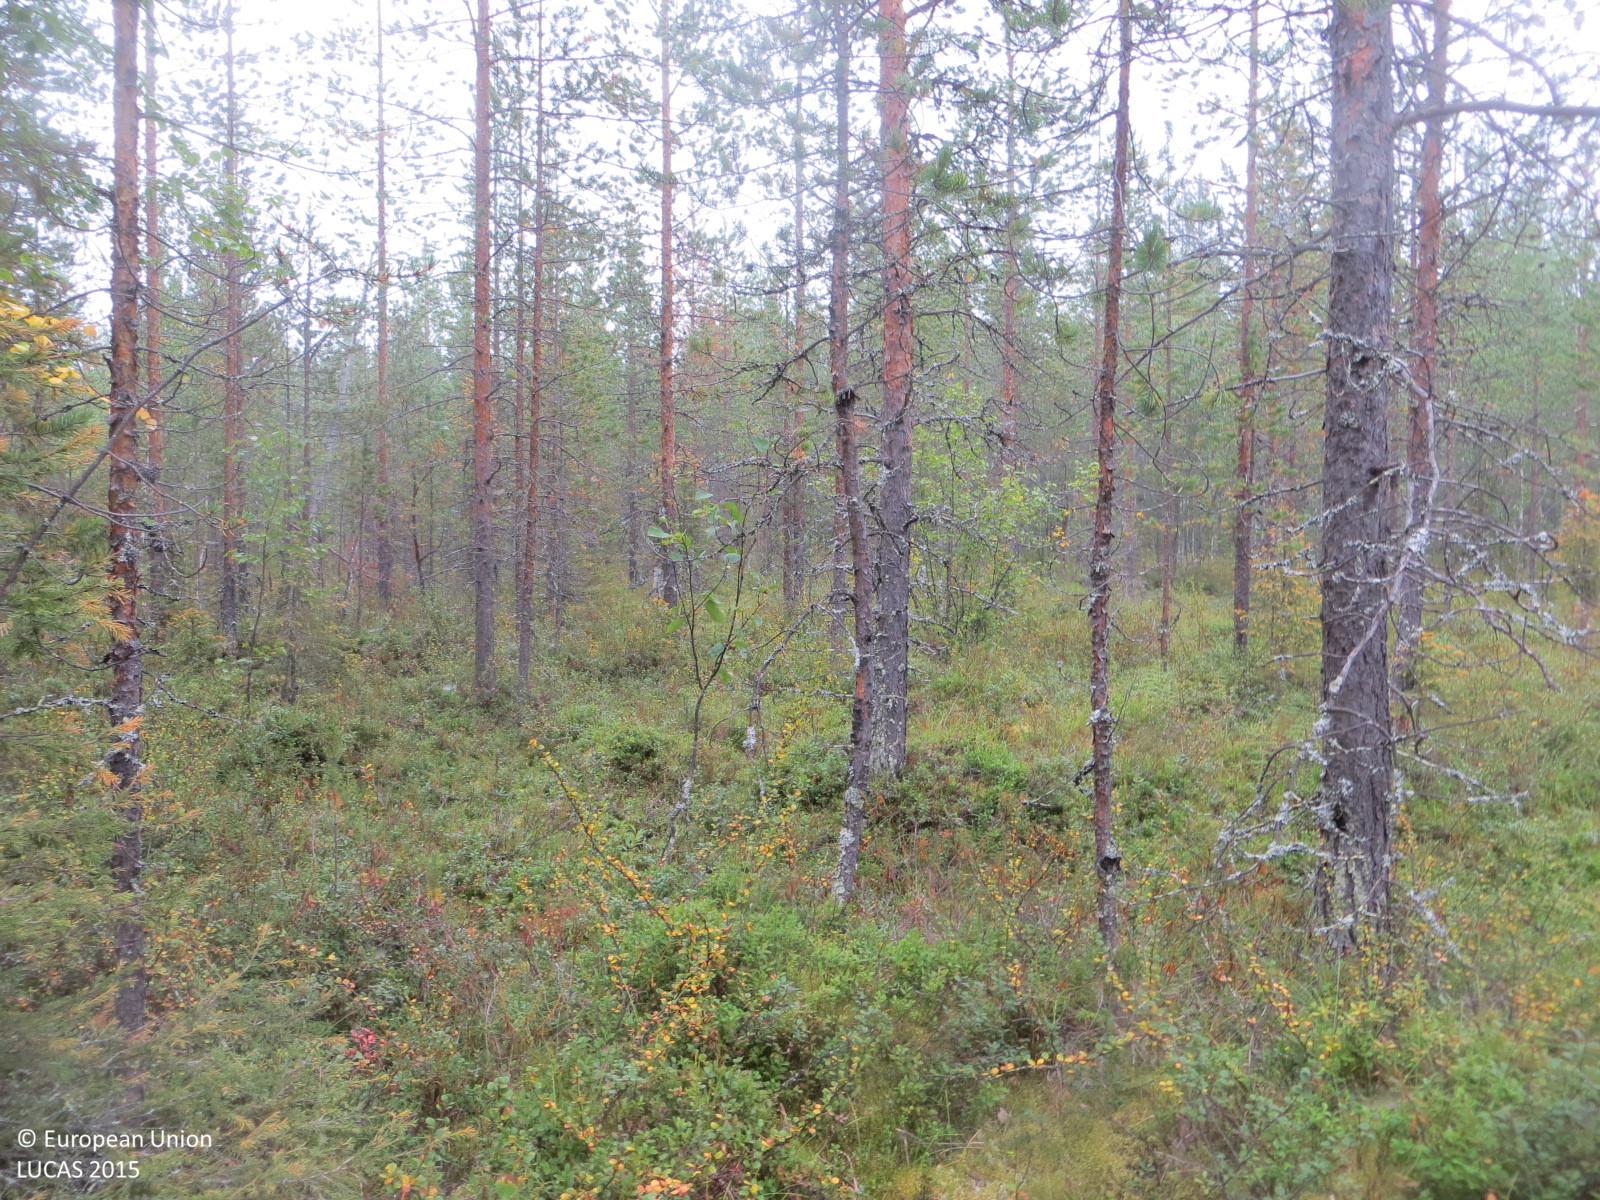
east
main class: Woodland
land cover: Pine dominated mixed woodland
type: mire and swamp forests
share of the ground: 50 - 75 %
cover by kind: coniferous forest trees 45 %, shrubs 30 %, broadleaved forest trees 25 %
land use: Forestry
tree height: > 5 m
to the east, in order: Pine dominated mixed woodland; Ditches and canals; Pine dominated mixed woodland; Ditches and canals; Pine dominated mixed woodland; Ditches and canals; Pine dominated mixed woodland
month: August
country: FI
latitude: 67.3572
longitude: 23.9198
